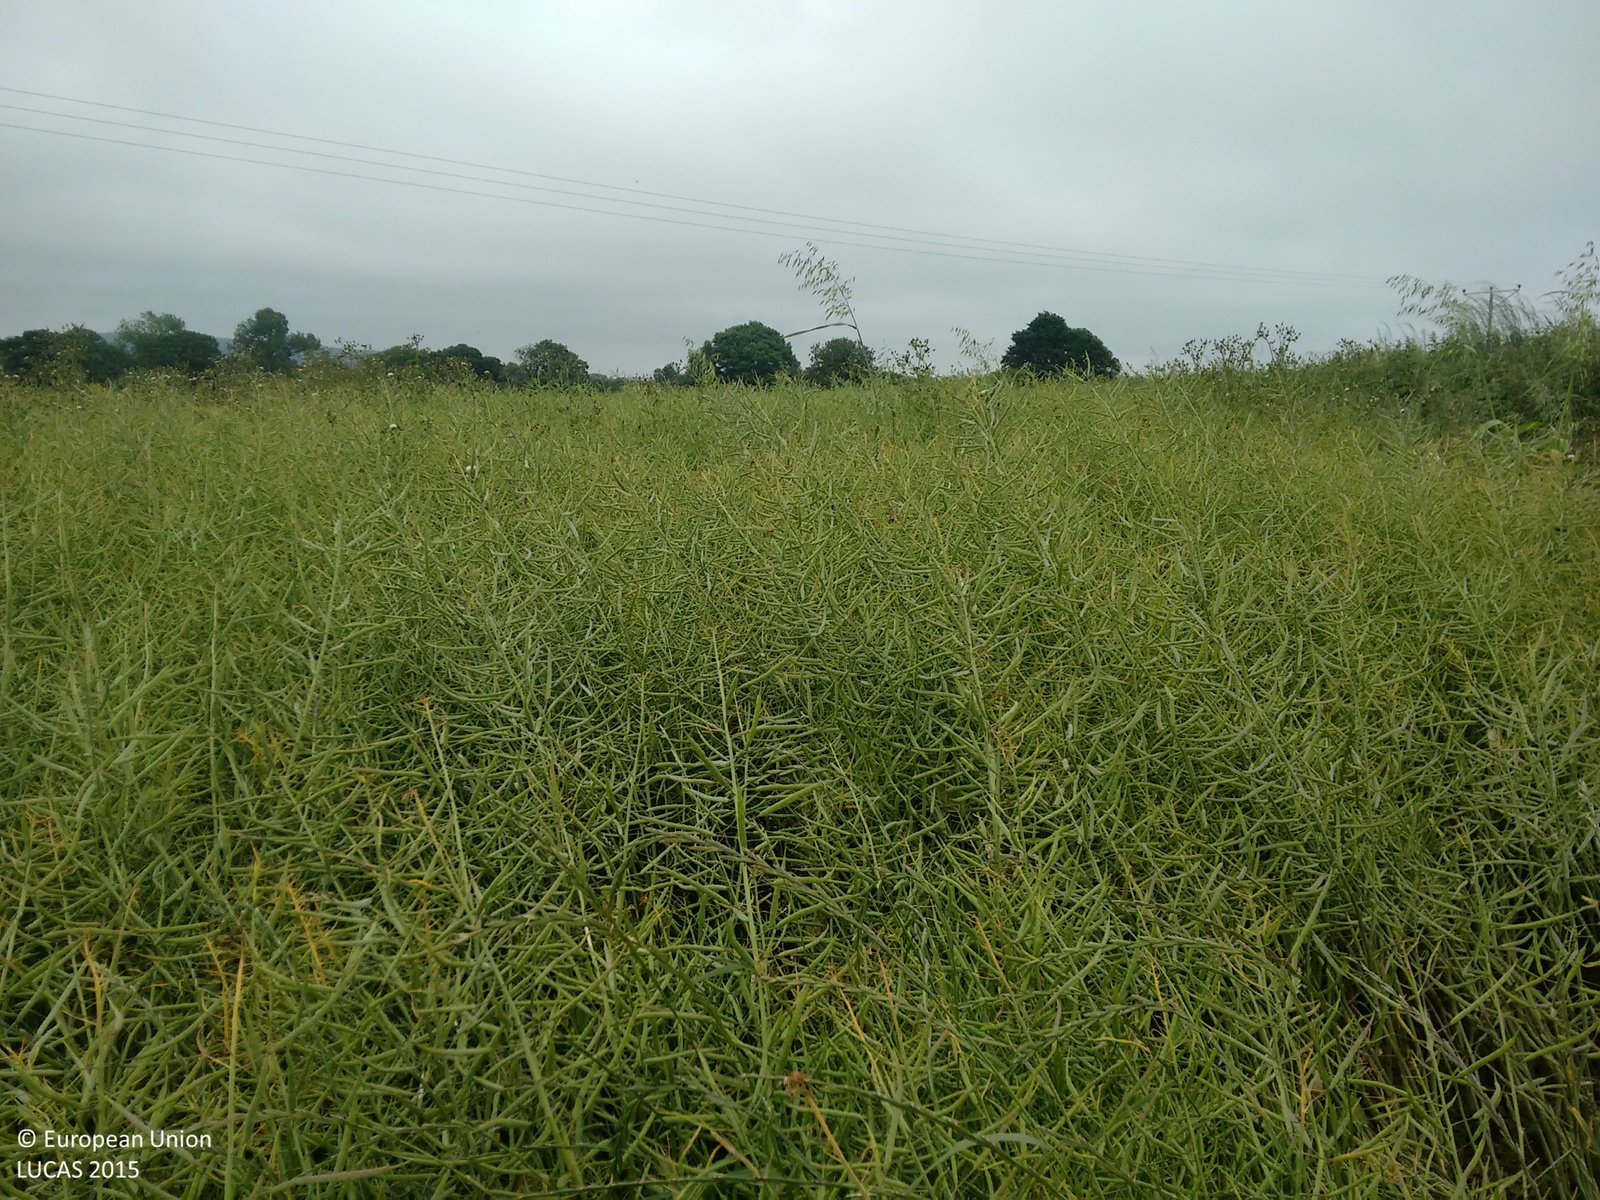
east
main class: Cropland
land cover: Dry pulses
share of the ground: > 75 %
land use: Agriculture (excluding fallow land and kitchen gardens)
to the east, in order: Dry pulses; Electric lines; Dry pulses; Ditches and canals; Abandoned hedges; Fences; Grassland without tree/shrub cover
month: June
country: IE
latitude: 52.4951
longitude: -7.2818
